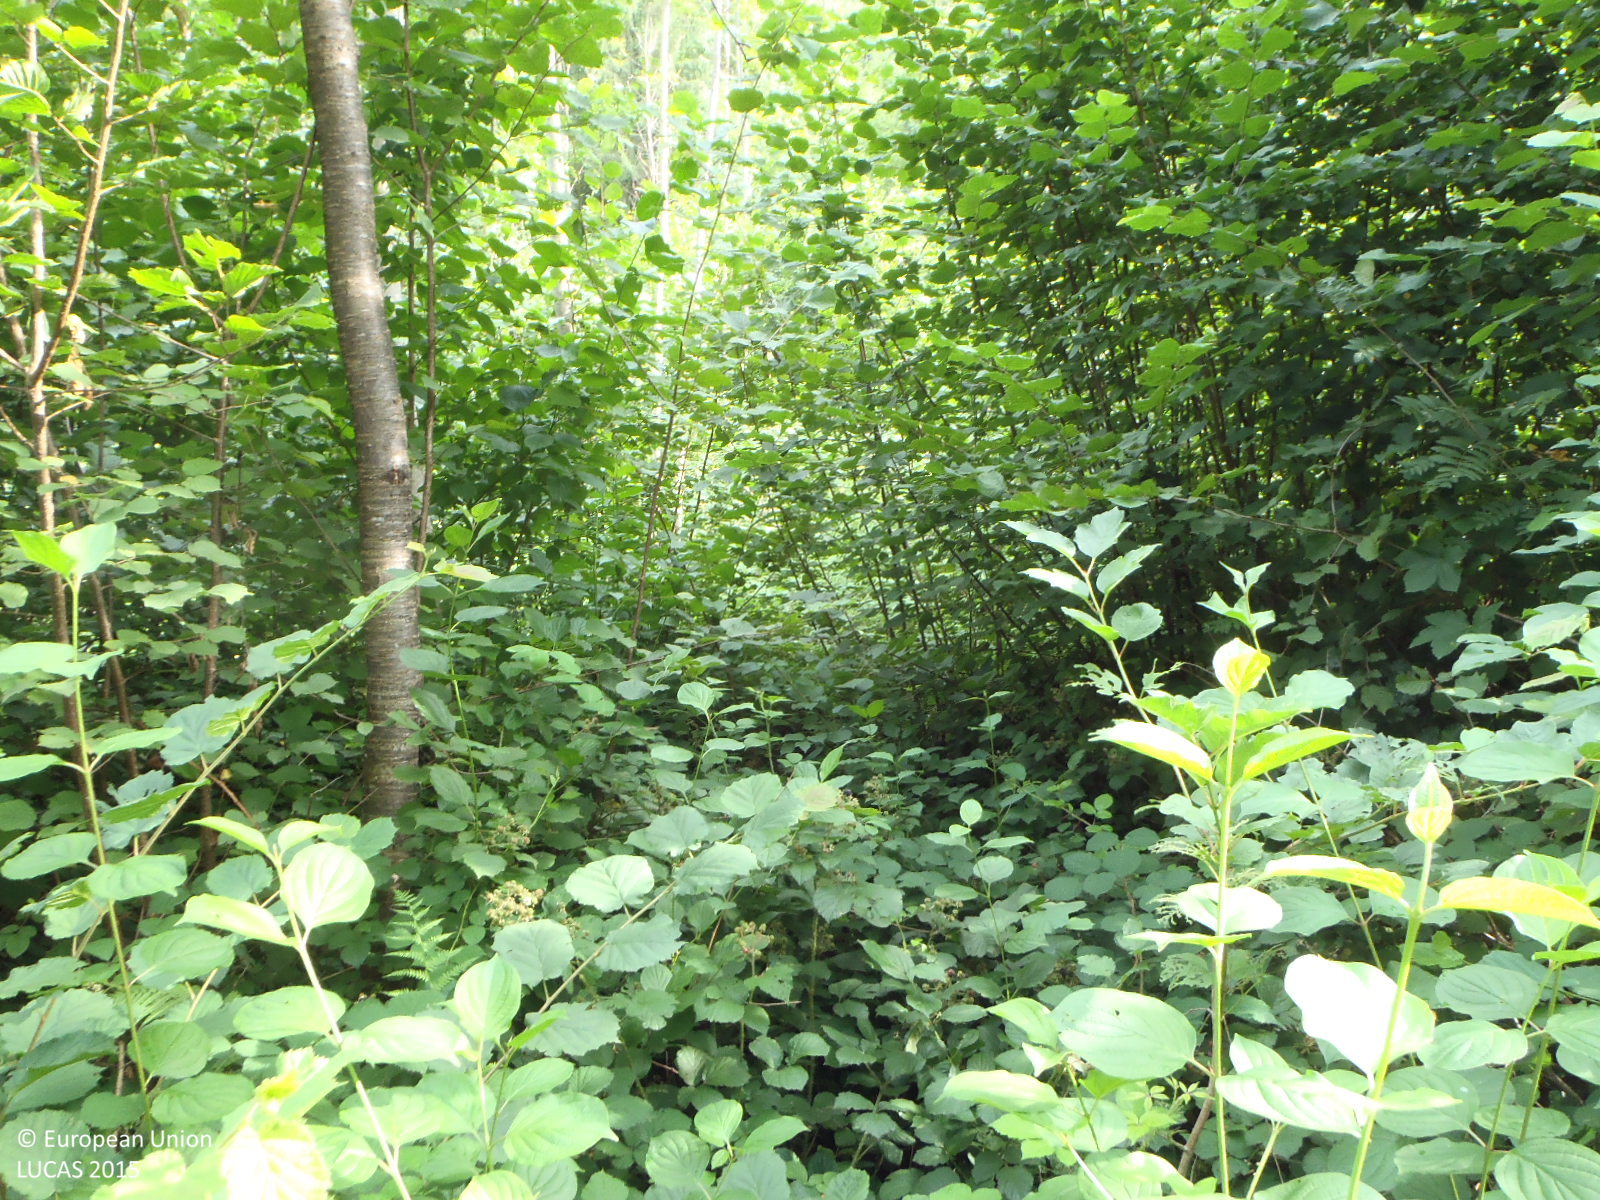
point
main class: Woodland
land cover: Broadleaved woodland
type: mountainous beech forest
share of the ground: > 75 %
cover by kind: broadleaved forest trees 50 %, shrubs 30 %, herbaceous plants 20 %
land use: Forestry
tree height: > 5 m
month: July
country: AT
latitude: 47.1971
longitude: 9.6703
